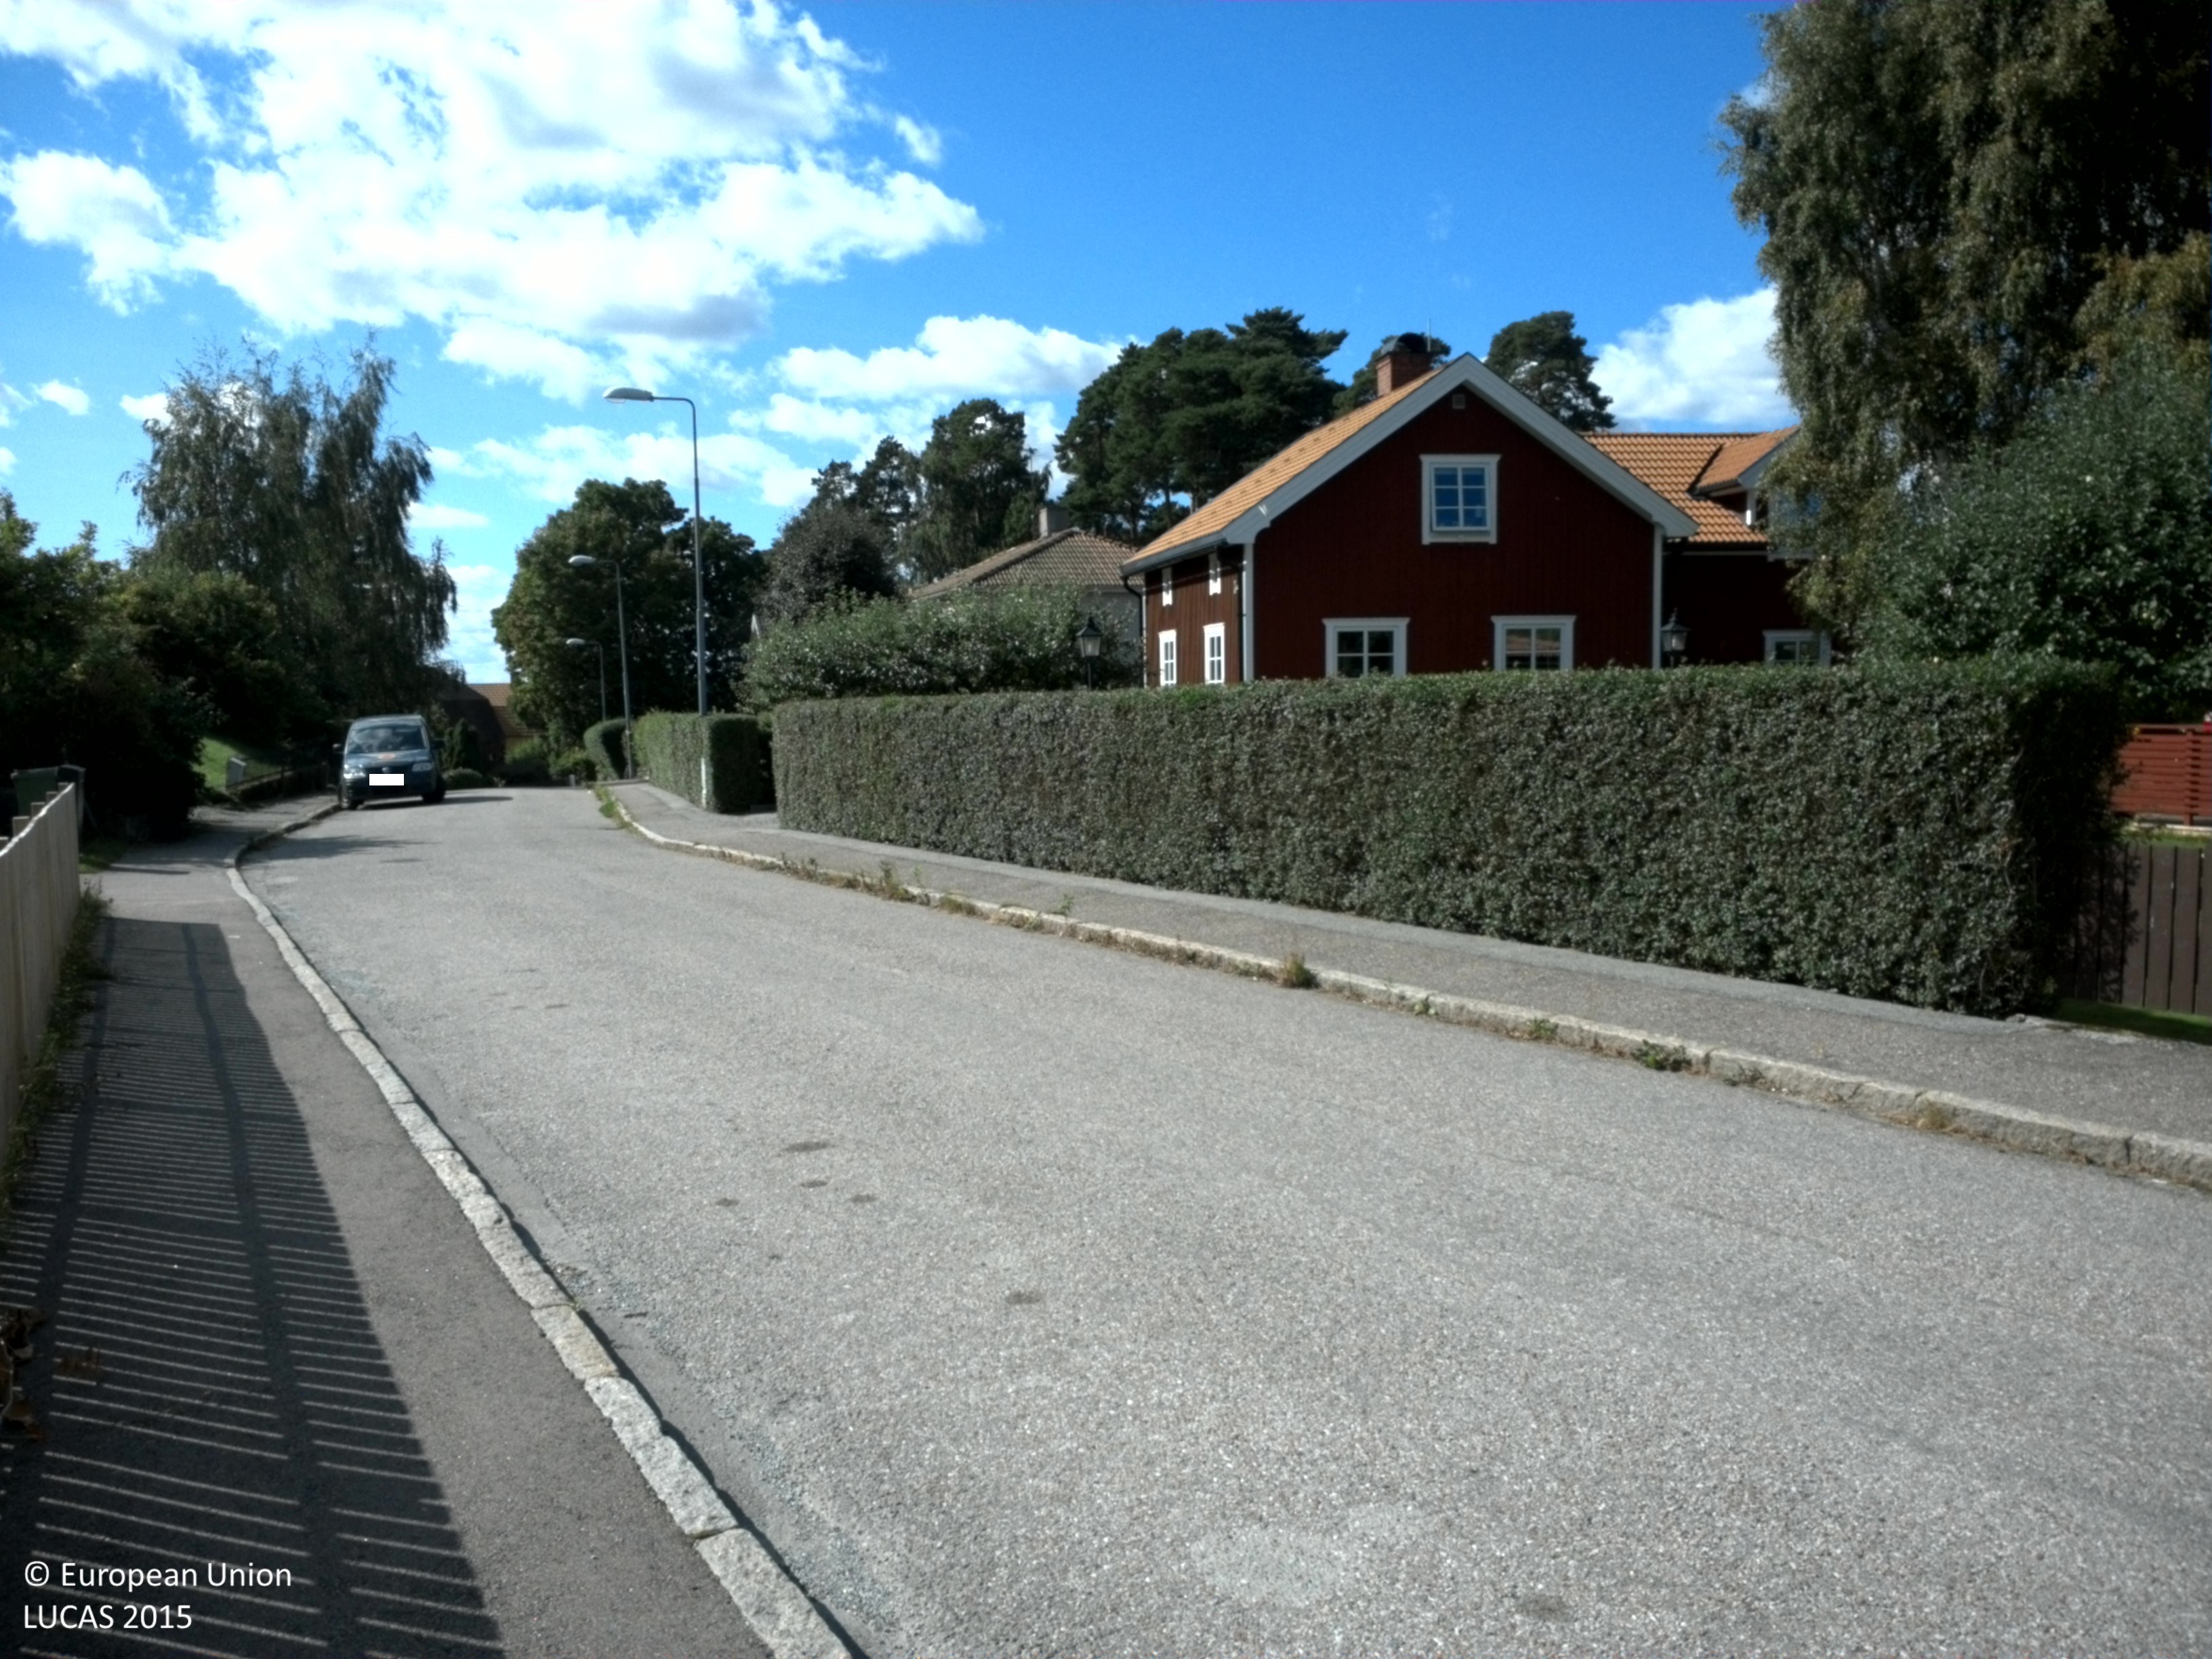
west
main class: Grassland
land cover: Grassland with sparse tree/shrub cover
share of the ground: > 75 %
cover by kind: herbaceous plants 95 %, broadleaved forest trees 5 %
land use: Residential
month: August
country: SE
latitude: 59.6399
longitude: 17.1063
